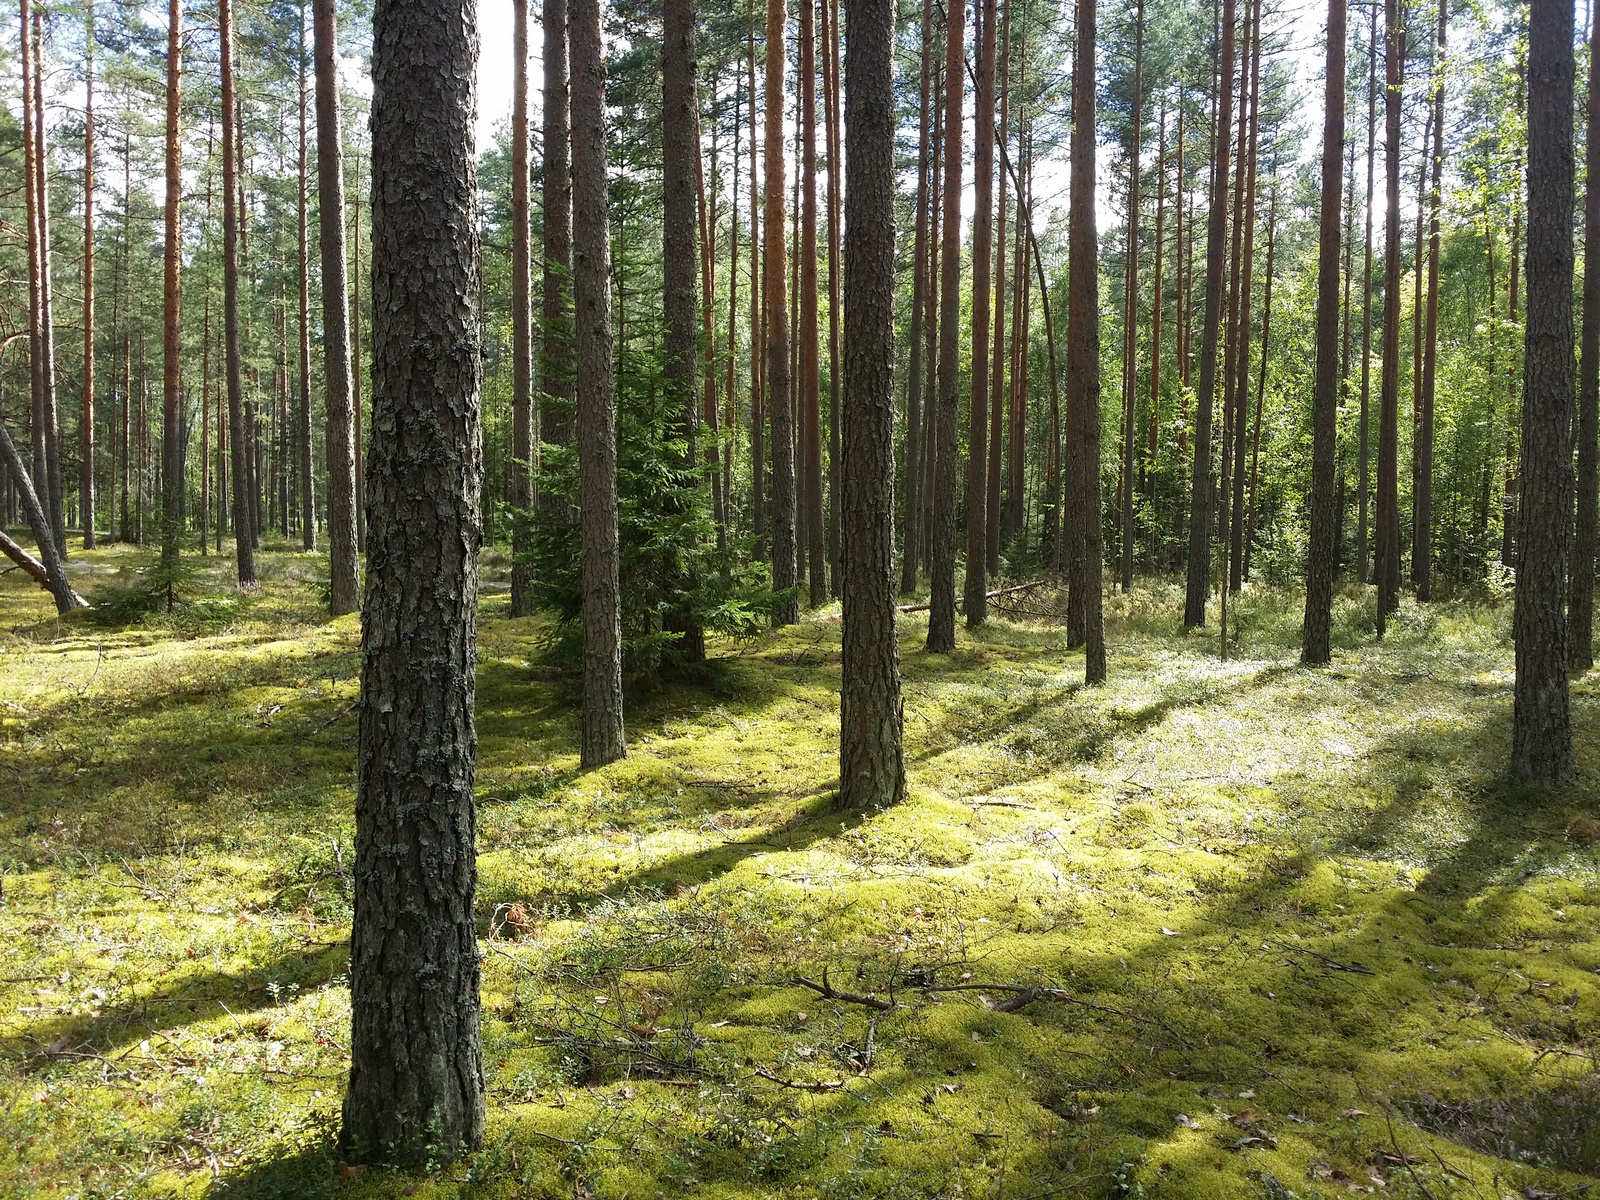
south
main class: Woodland
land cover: Pine dominated coniferous woodland
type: hemiboreal forest and nemoral coniferous forest and mixed broadleaved-coniferous forest
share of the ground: 50 - 75 %
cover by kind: coniferous forest trees 70 %, lichens and mosses 25 %, shrubs 5 %
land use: Forestry
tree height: > 5 m
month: August
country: LV
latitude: 57.3119
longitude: 27.6622
